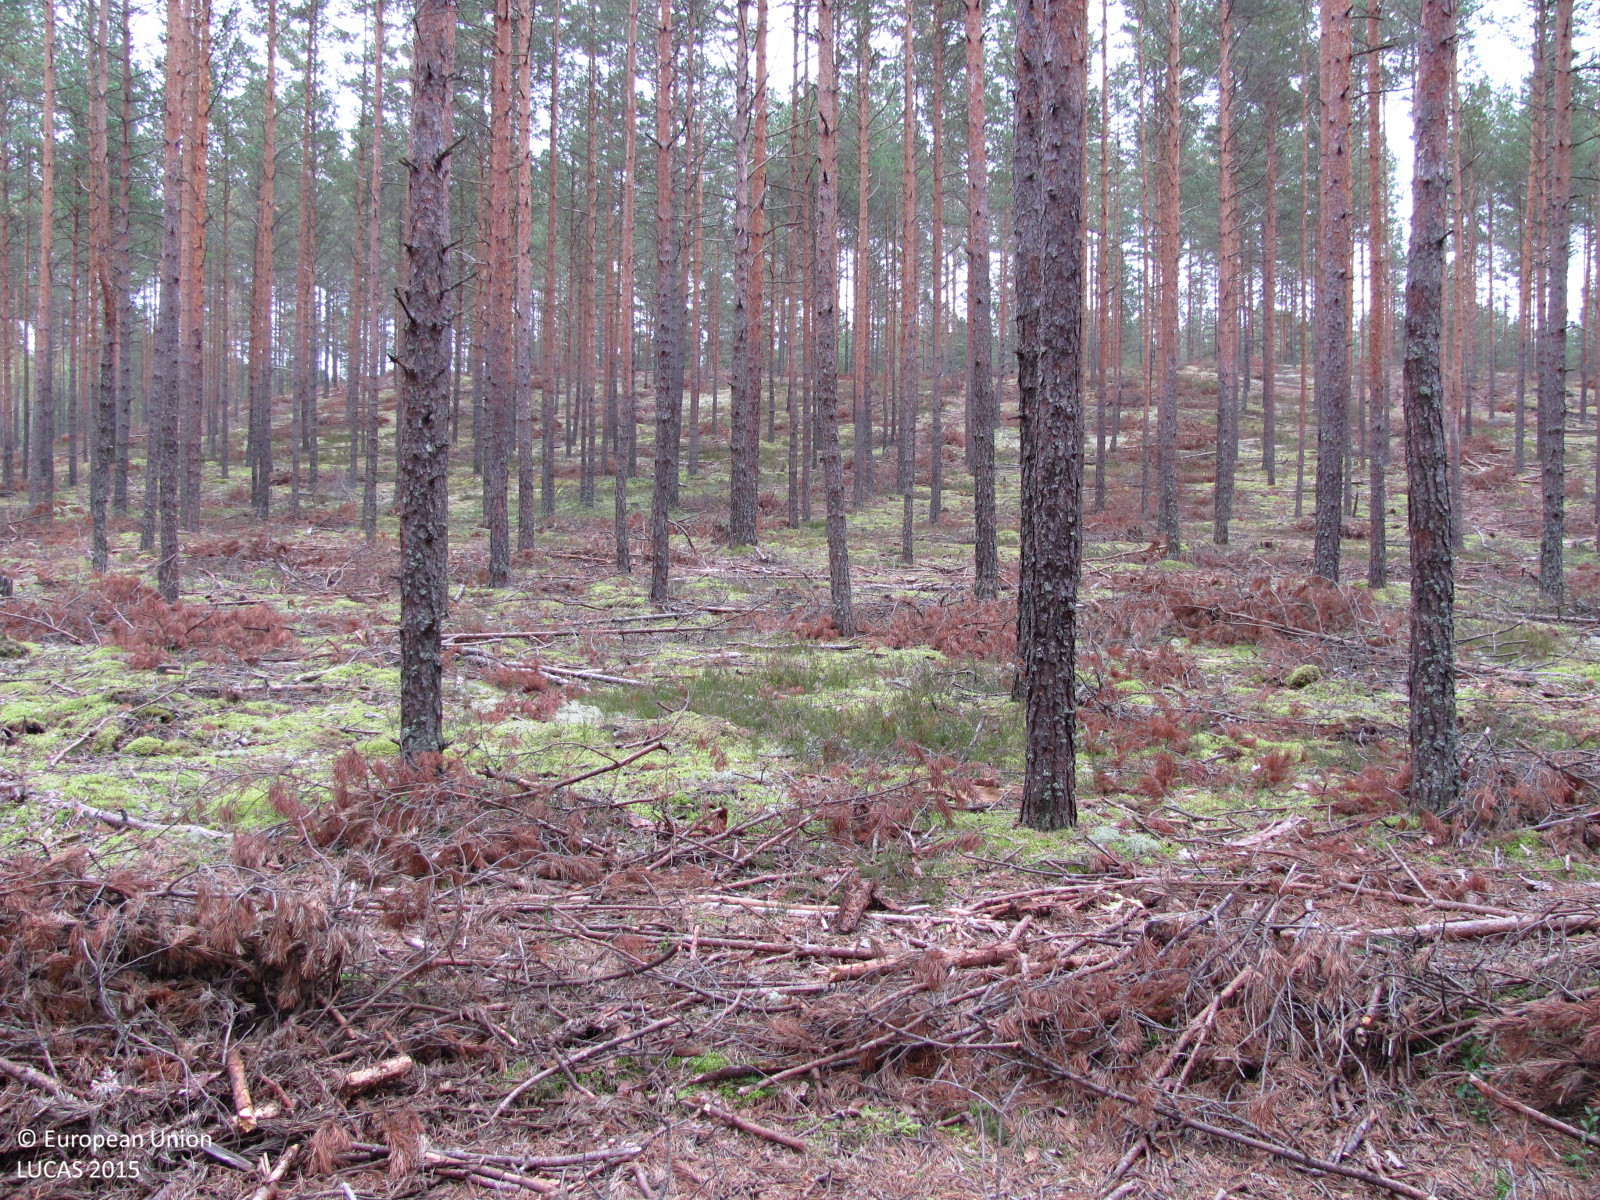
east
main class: Woodland
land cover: Pine dominated coniferous woodland
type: hemiboreal forest and nemoral coniferous forest and mixed broadleaved-coniferous forest
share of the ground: > 75 %
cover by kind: coniferous forest trees 80 %, lichens and mosses 15 %, herbaceous plants 5 %
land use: Forestry
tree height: > 5 m
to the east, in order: Pine dominated coniferous woodland; Tracks; Pine dominated coniferous woodland; Pine dominated mixed woodland; Other mixed woodland; Spruce dominated mixed woodland
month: September
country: LV
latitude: 57.0759
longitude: 24.5281
